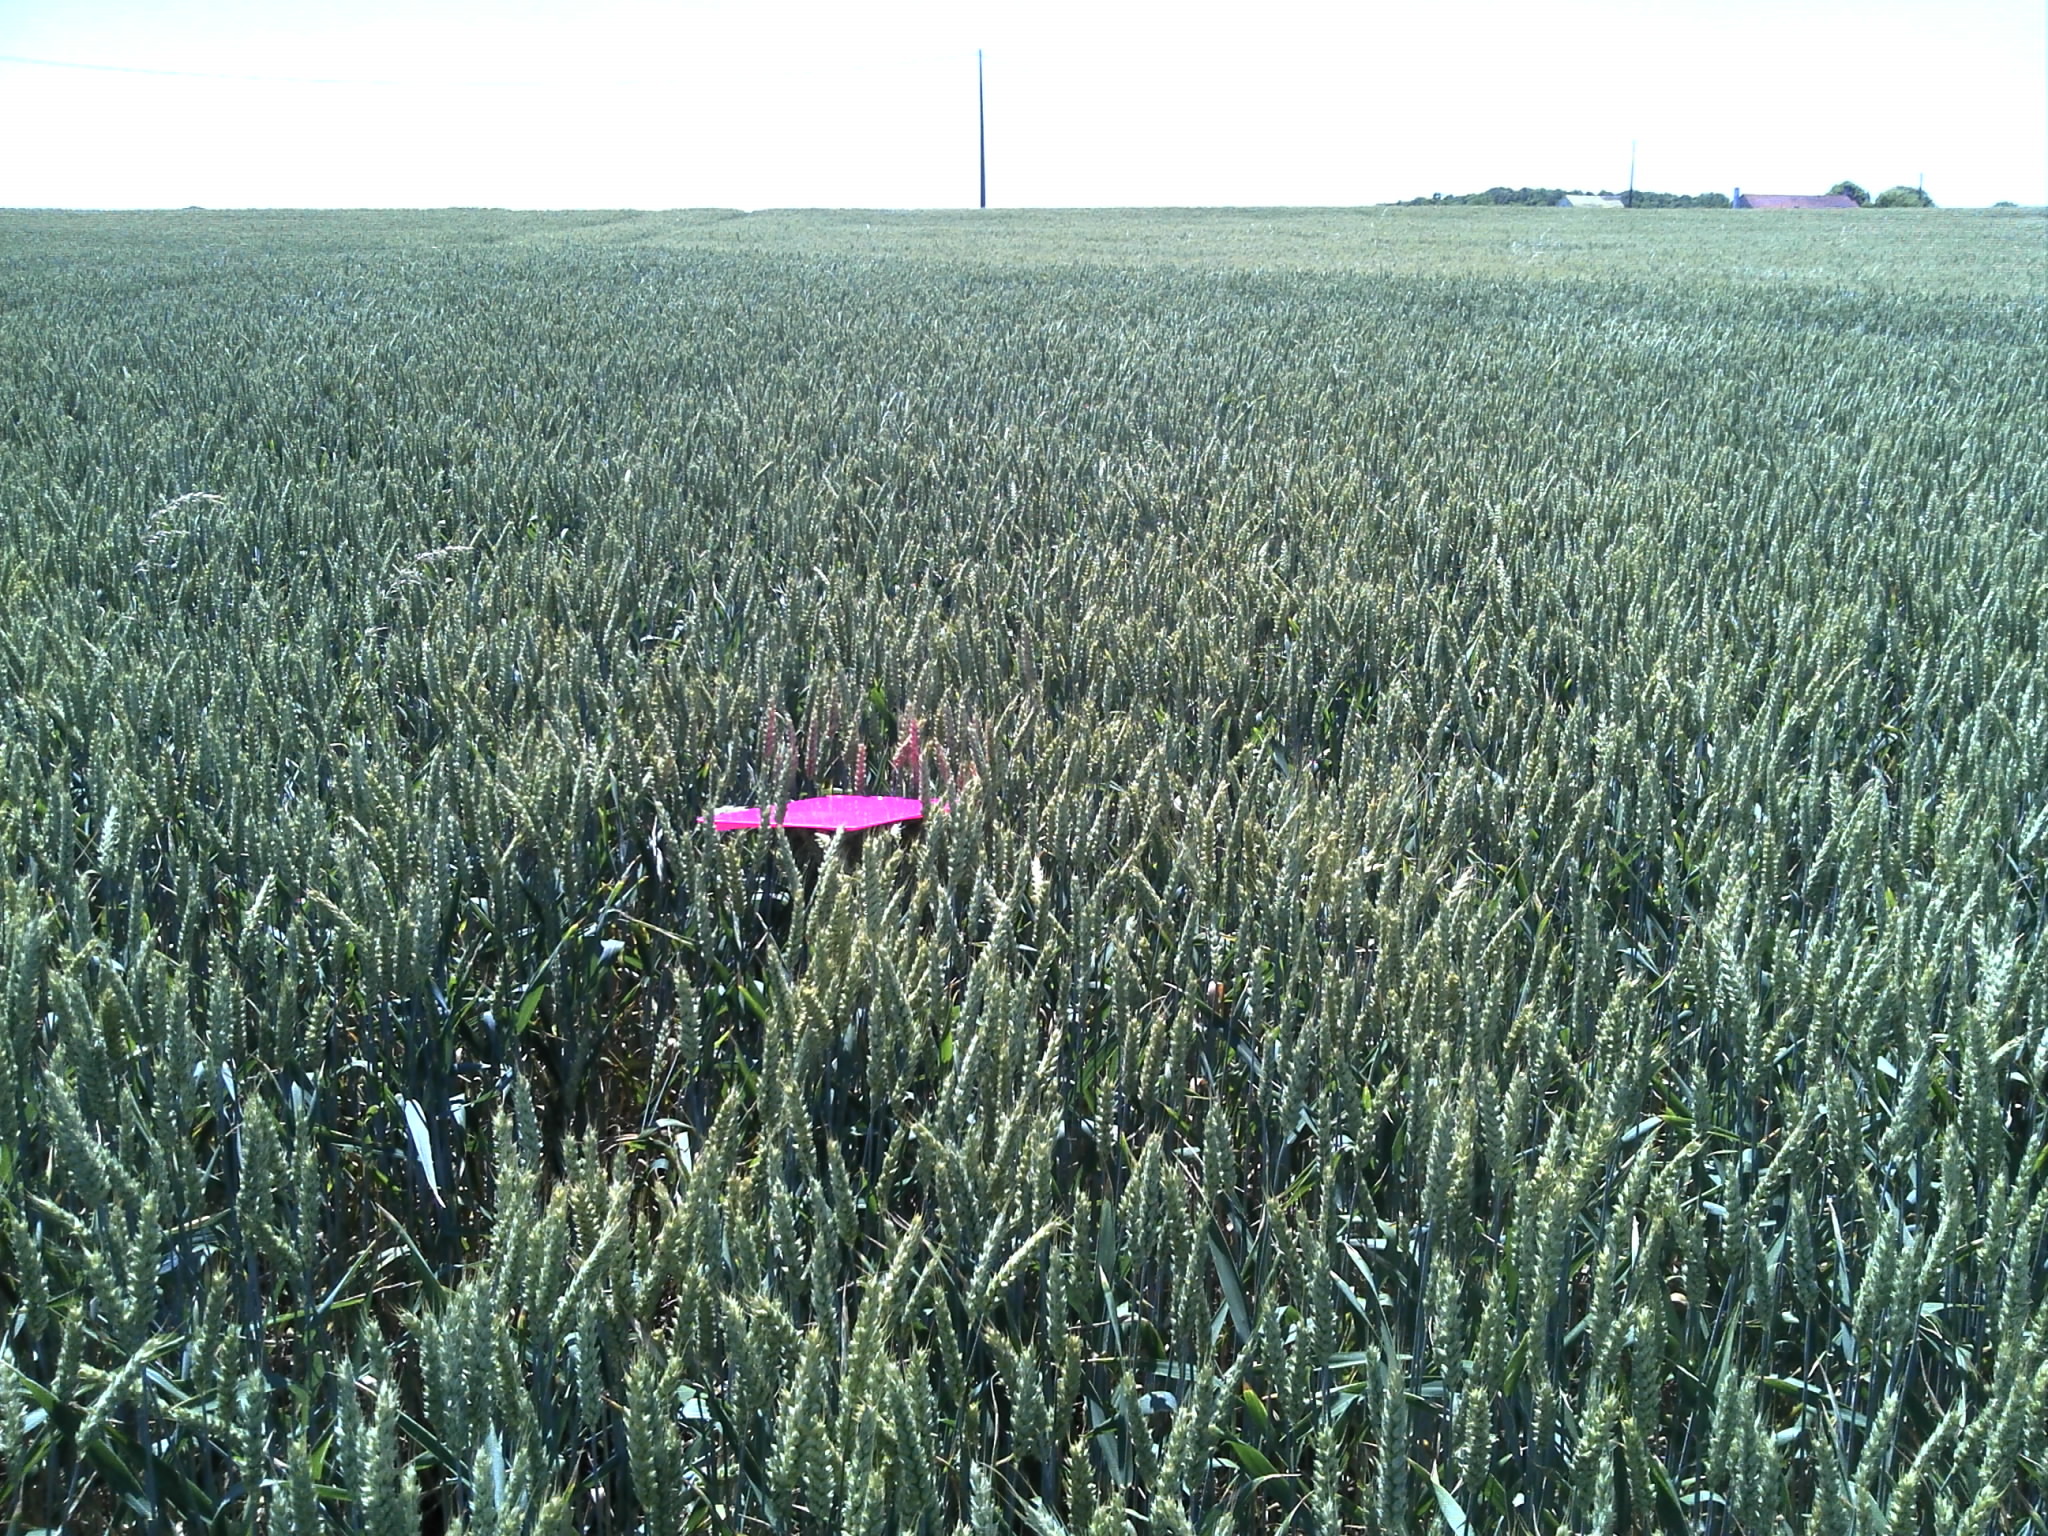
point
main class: Cropland
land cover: Common wheat
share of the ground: > 75 %
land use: Agriculture (excluding fallow land and kitchen gardens)
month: June
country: FR
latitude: 47.1651
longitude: 1.4254
